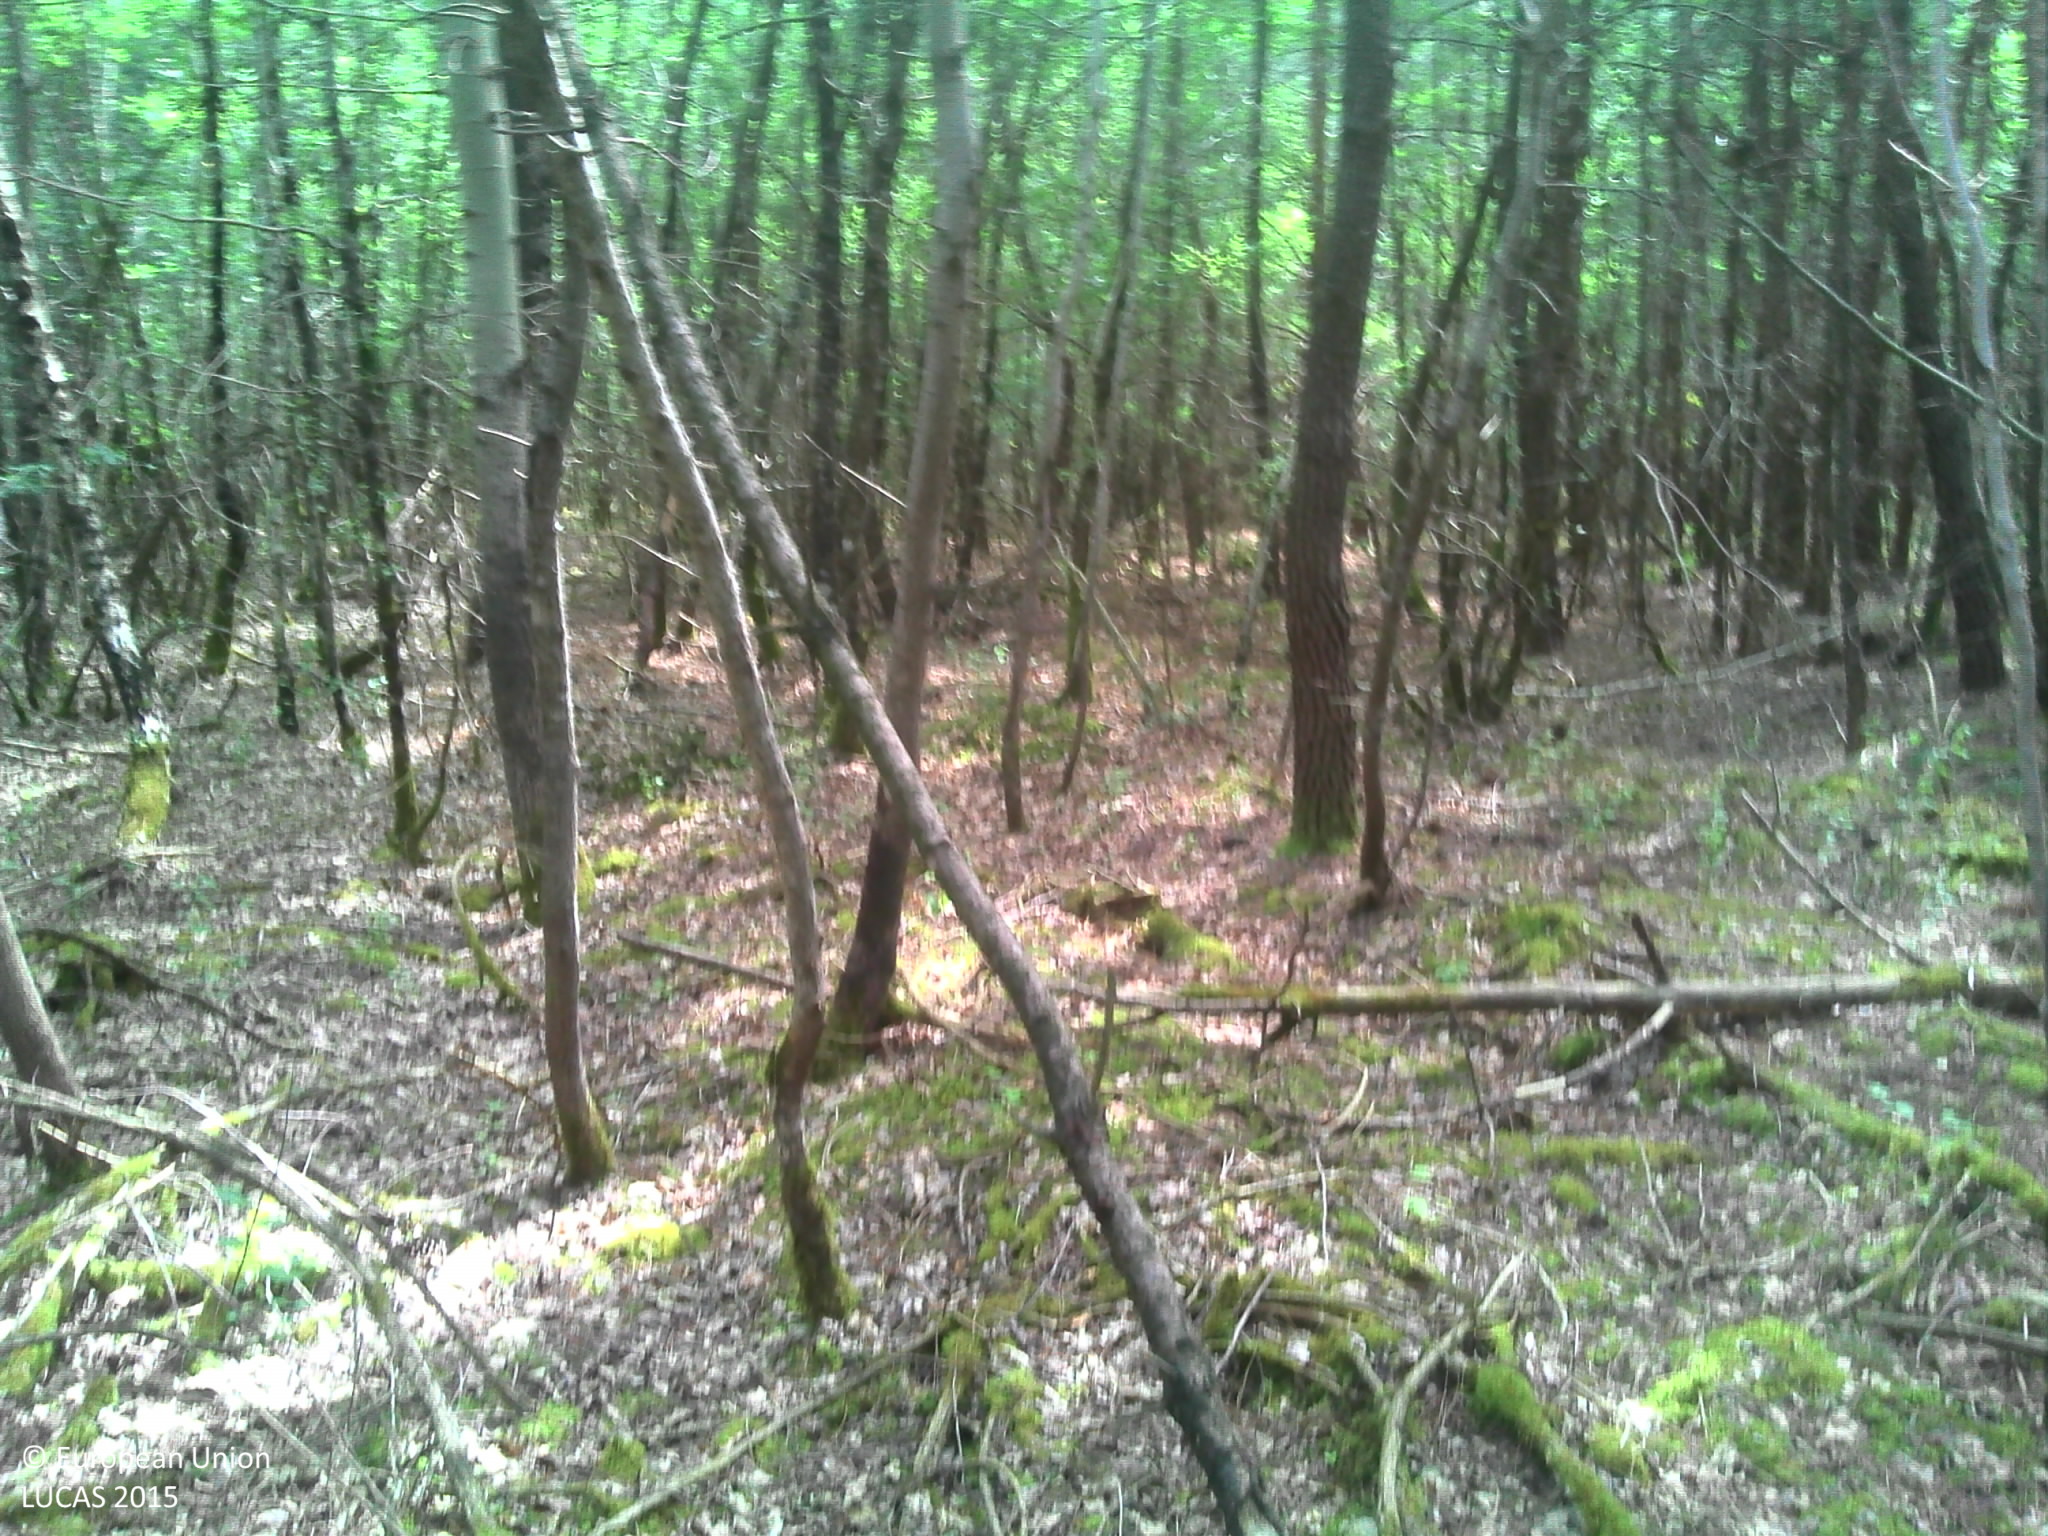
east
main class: Woodland
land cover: Pine dominated mixed woodland
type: thermophilous deciduous forest
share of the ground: > 75 %
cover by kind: unconsolidated bare surface 30 %, herbaceous plants 20 %, lichens and mosses 20 %, coniferous forest trees 15 %, broadleaved forest trees 15 %
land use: Forestry
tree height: > 5 m
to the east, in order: Pine dominated mixed woodland; Tracks; Pine dominated mixed woodland; Broadleaved woodland
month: June
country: FR
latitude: 47.3417
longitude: 1.3694
